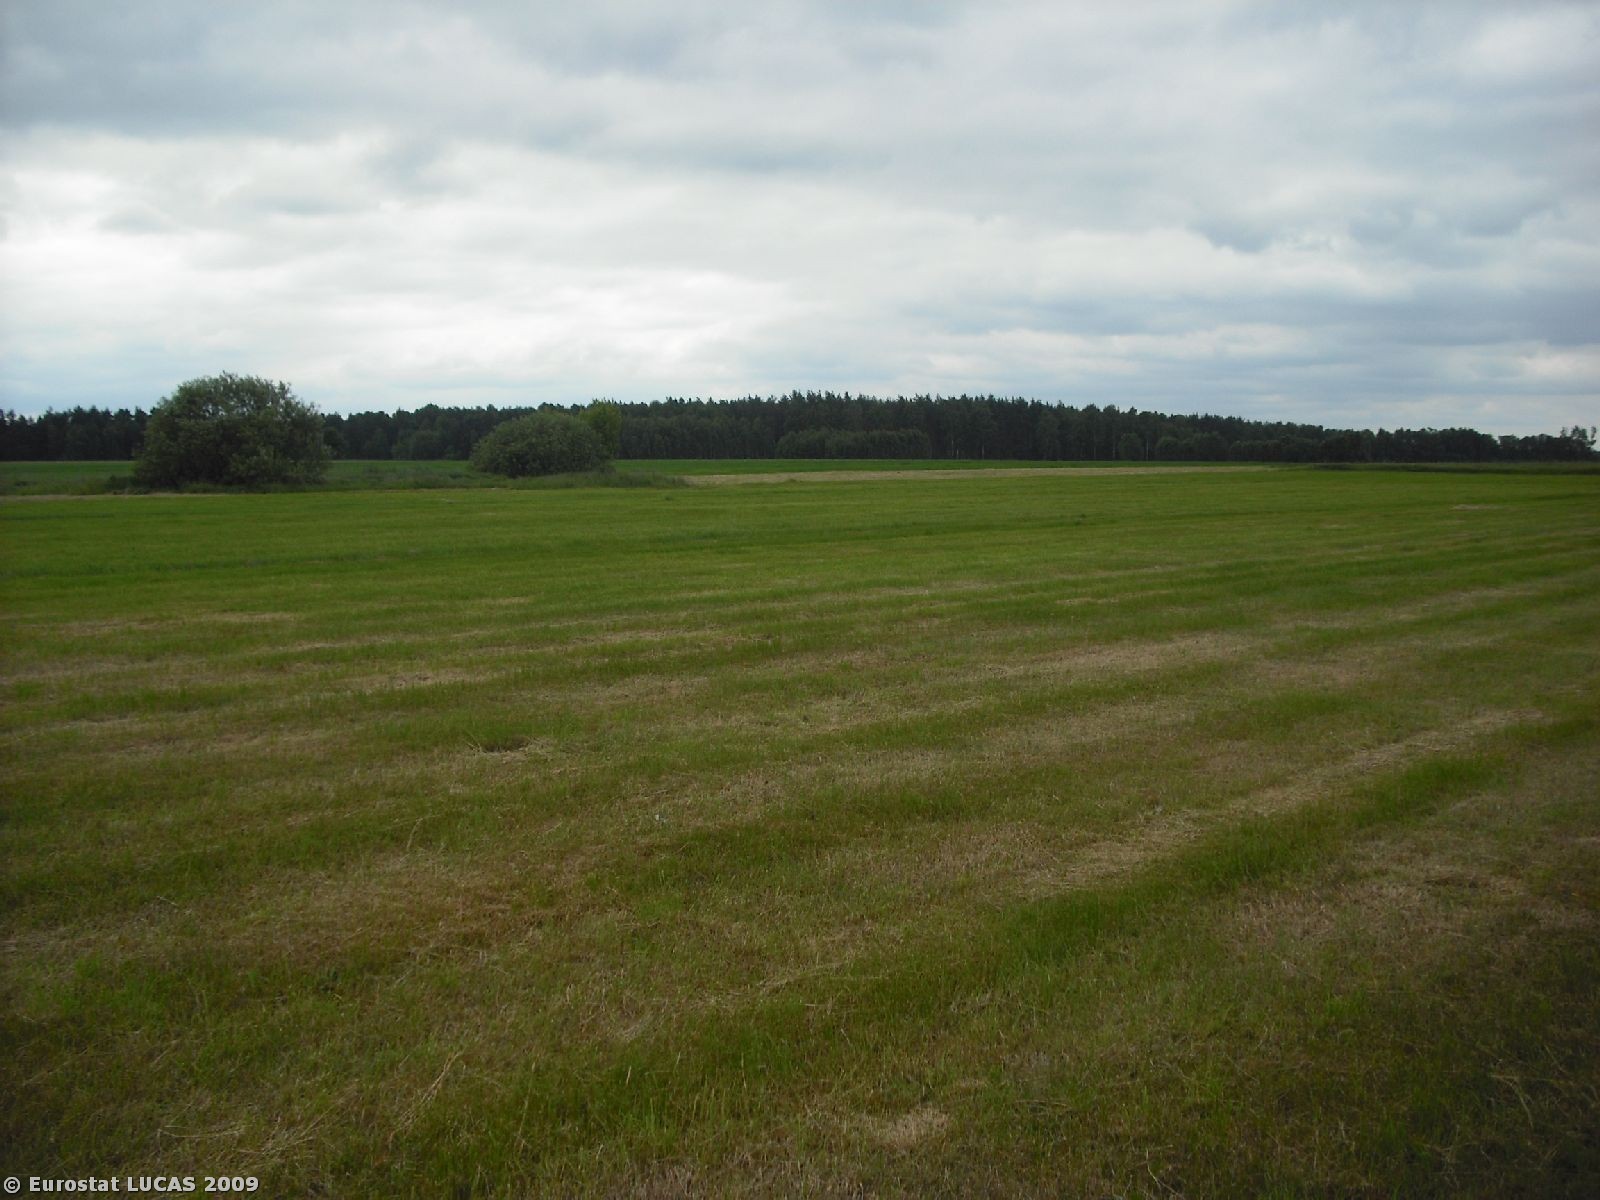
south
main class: Grassland
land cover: Grassland without tree/shrub cover
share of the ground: > 75 %
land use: Agriculture (excluding fallow land and kitchen gardens)
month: June
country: PL
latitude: 52.6723
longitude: 22.3833
